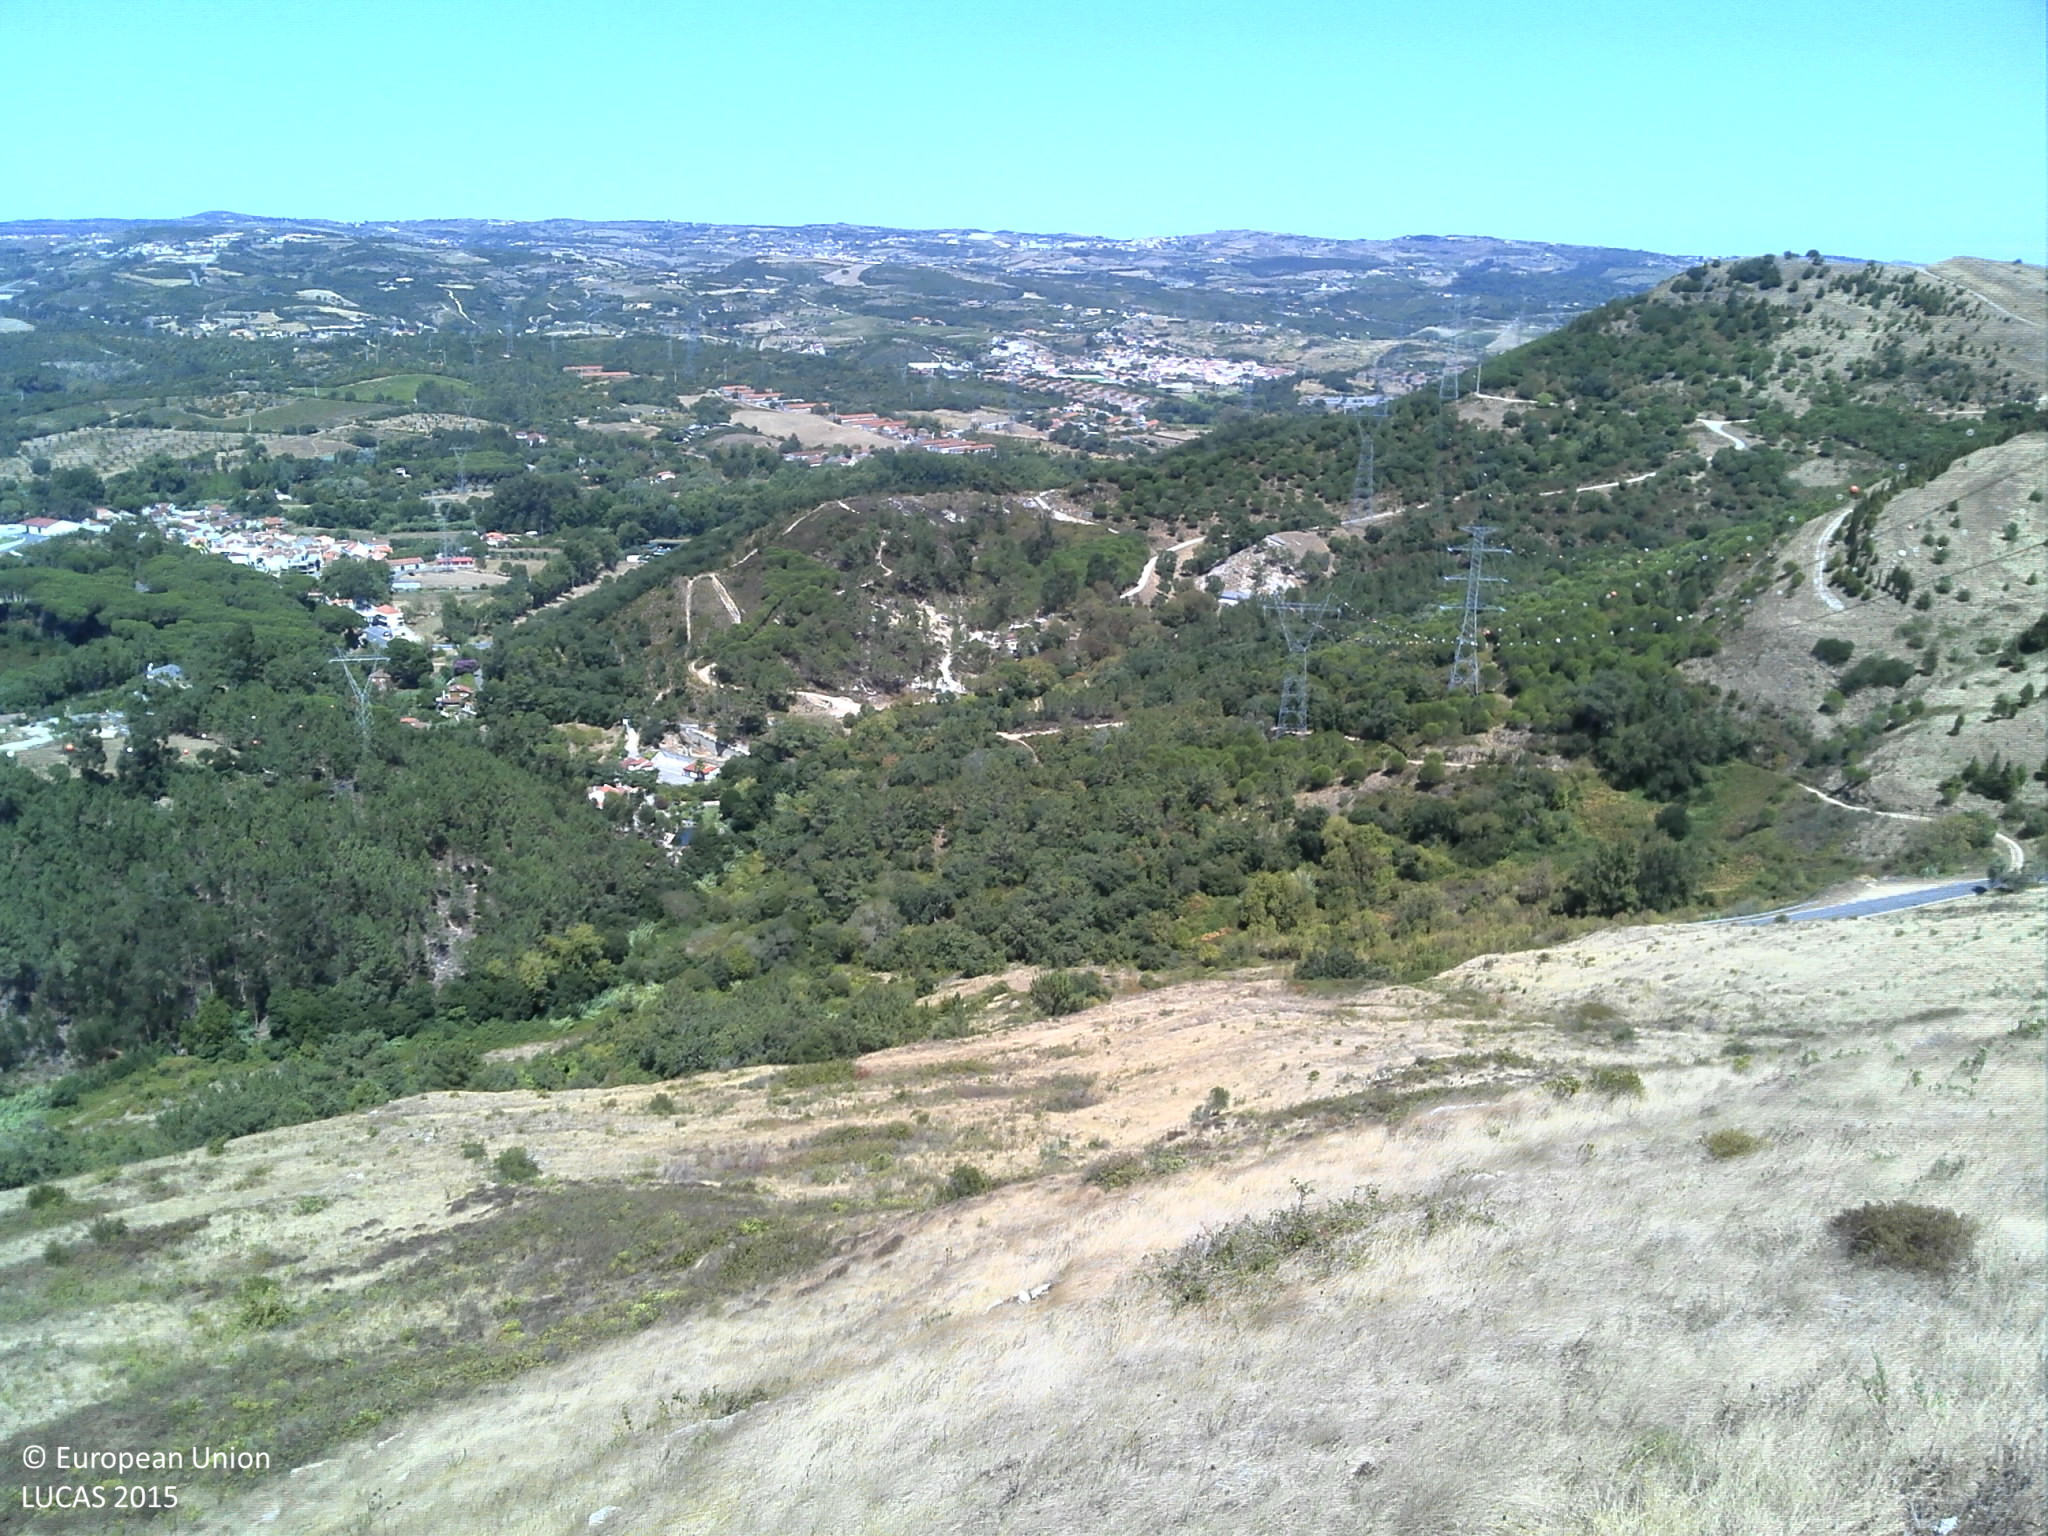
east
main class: Grassland
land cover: Grassland without tree/shrub cover
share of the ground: 50 - 75 %
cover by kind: herbaceous plants 70 %, unconsolidated bare surface 30 %
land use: Semi-natural and natural areas not in use
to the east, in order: Grassland without tree/shrub cover; Electric lines; Grassland without tree/shrub cover; Electric lines; Grassland without tree/shrub cover
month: August
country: PT
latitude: 38.8961
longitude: -9.1613
